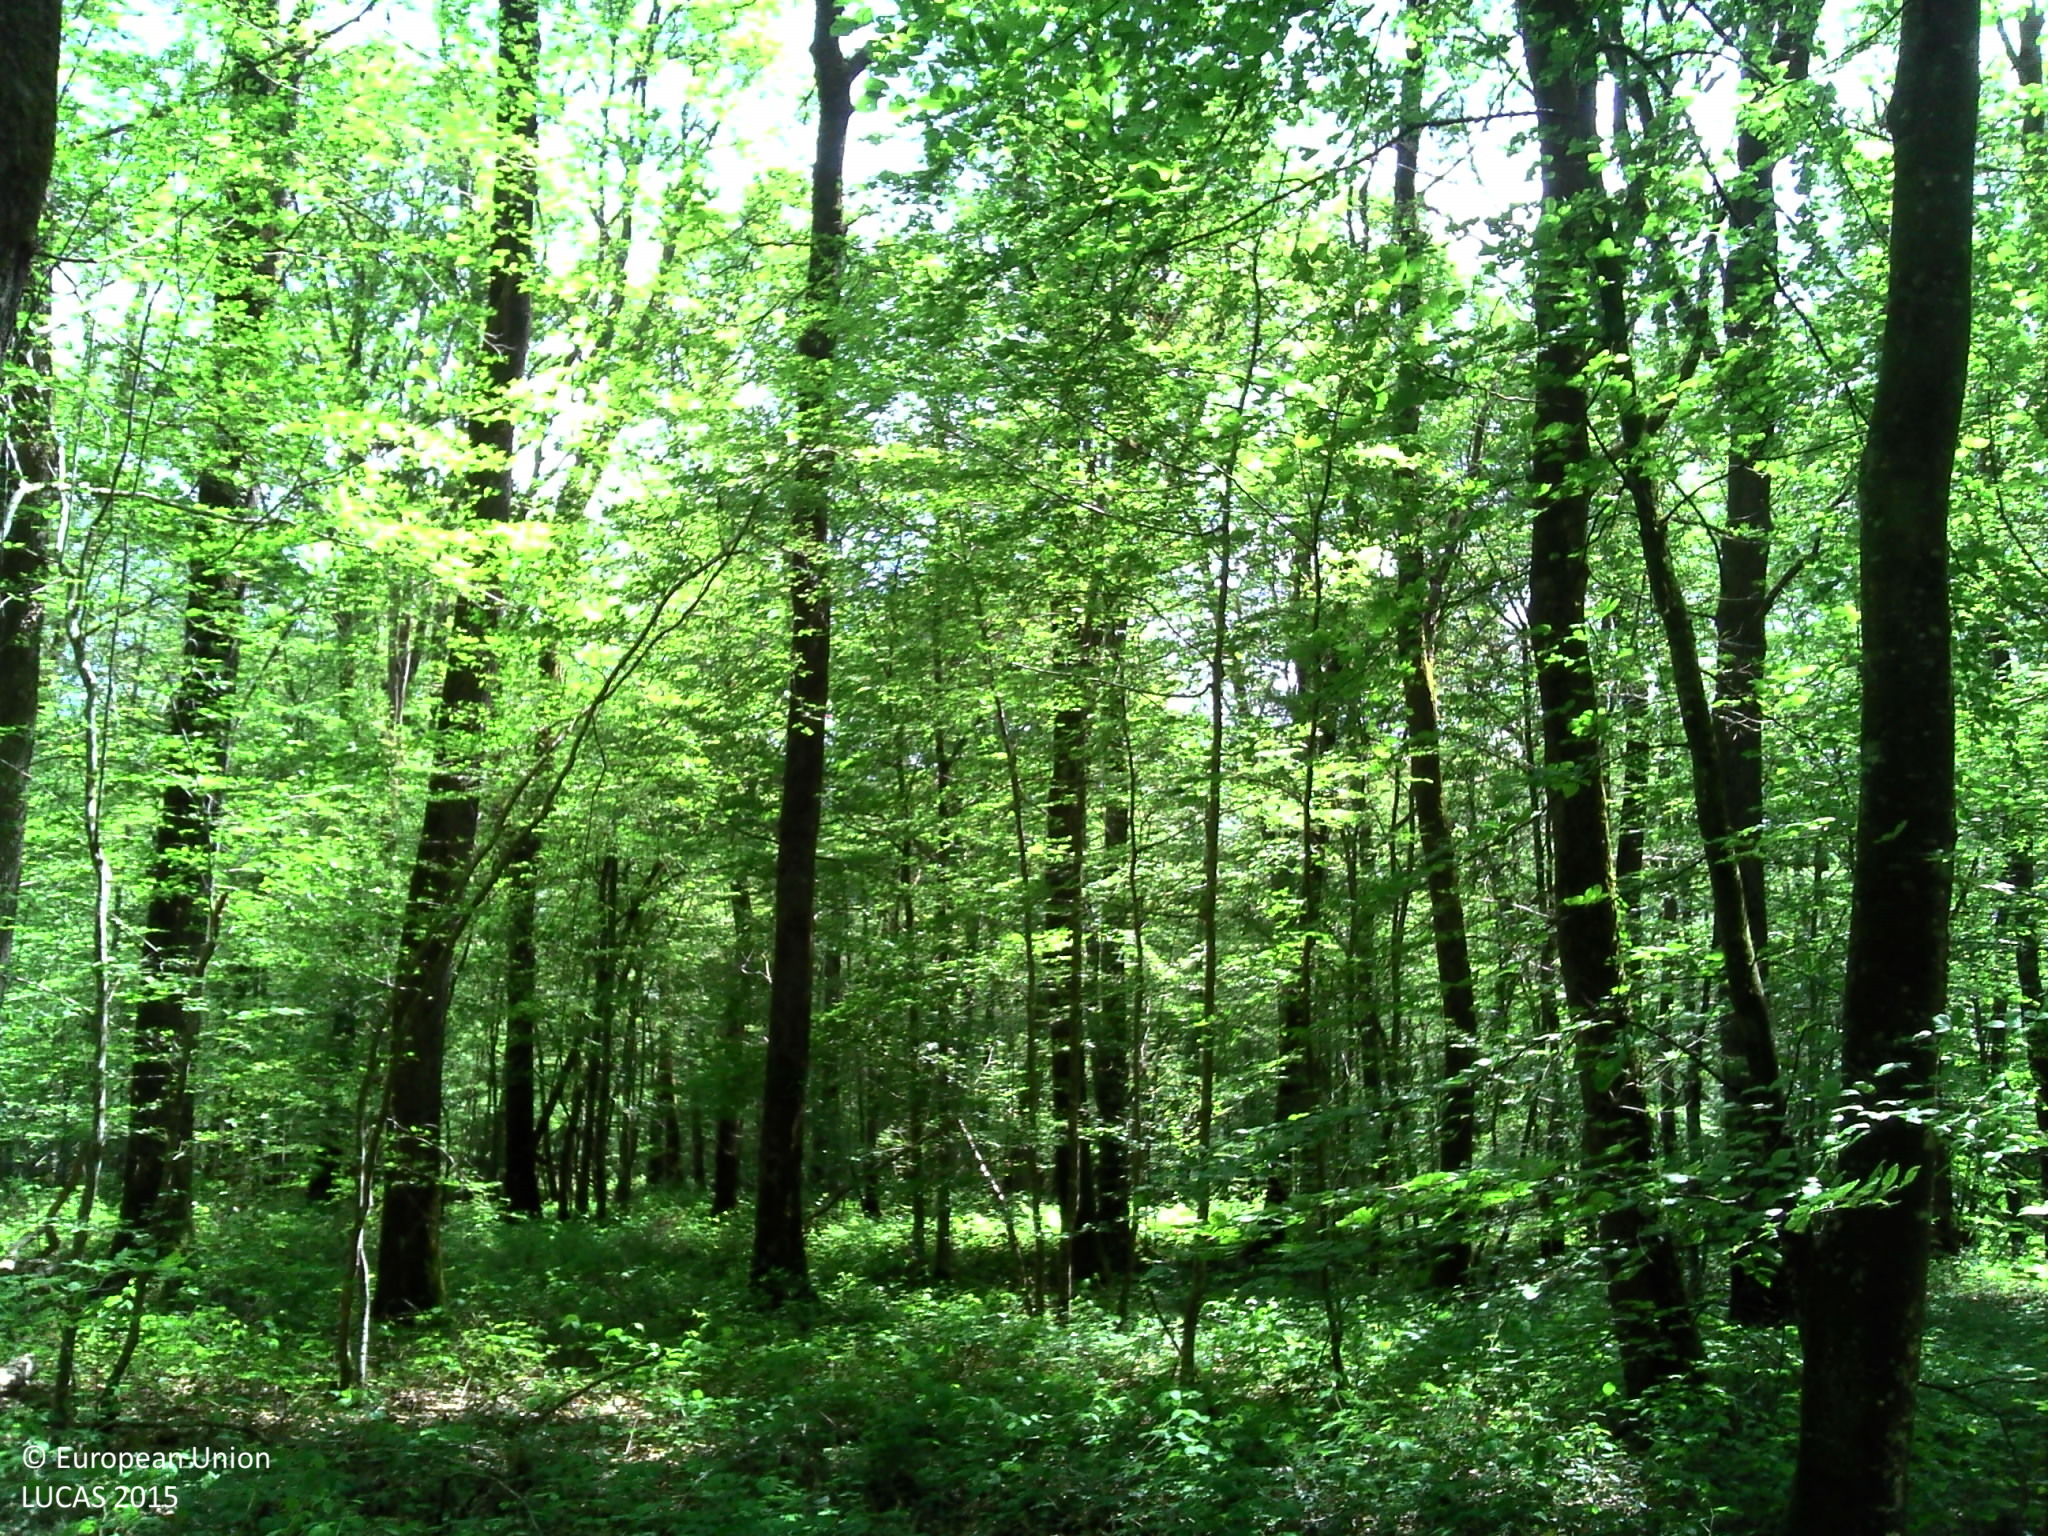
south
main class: Woodland
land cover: Broadleaved woodland
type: beech forest
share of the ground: > 75 %
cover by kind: broadleaved forest trees 90 %, shrubs 10 %
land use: Forestry
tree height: > 5 m
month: May
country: FR
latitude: 47.2520
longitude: 2.8725
